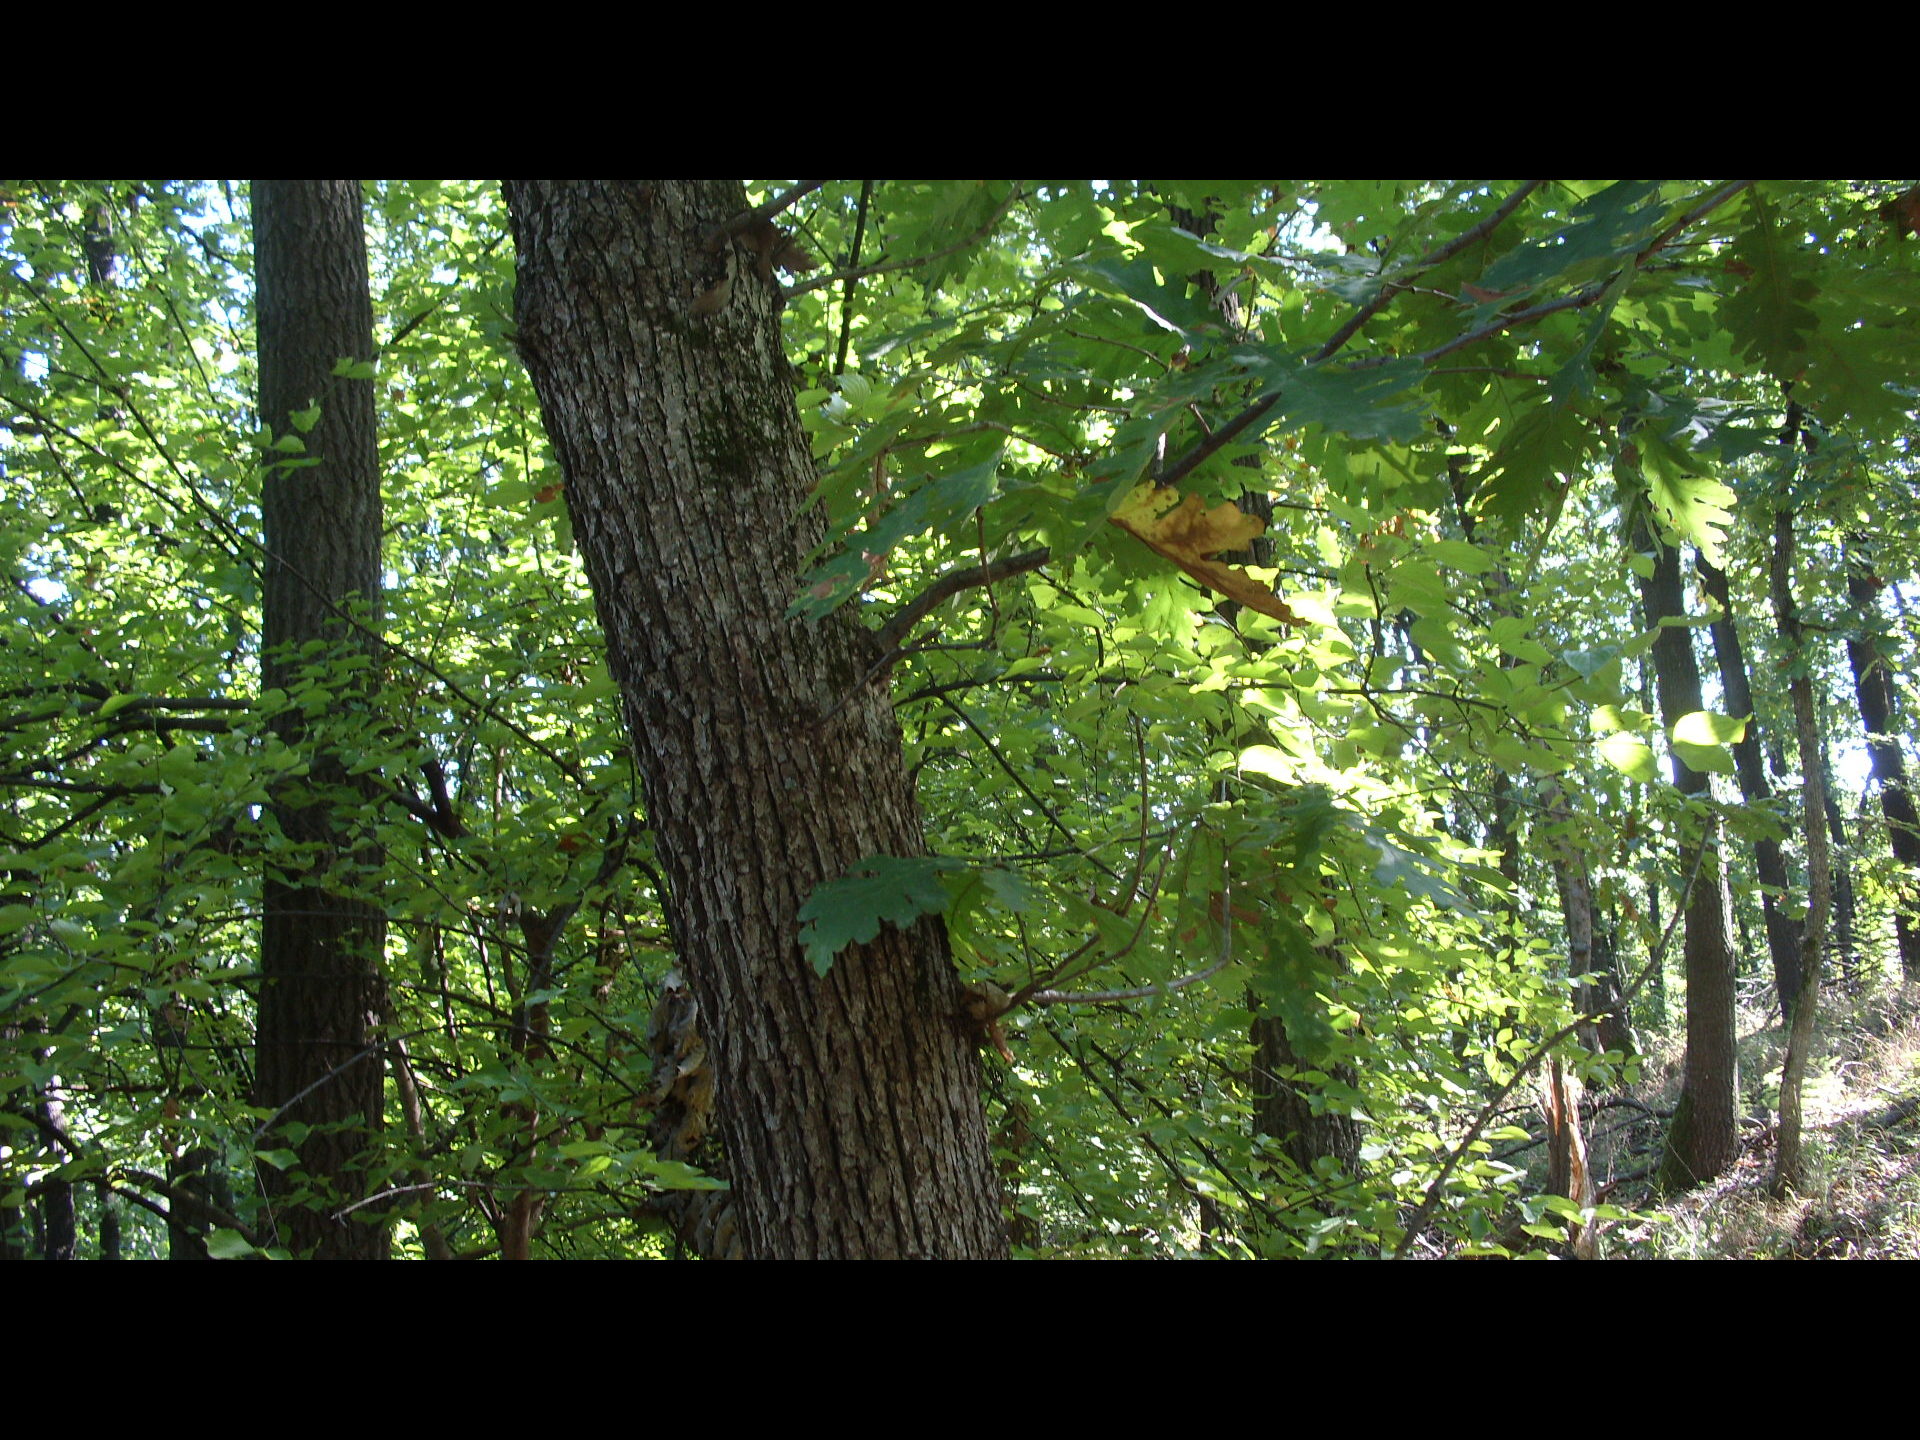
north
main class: Woodland
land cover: Broadleaved woodland
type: mesophytic deciduous forest
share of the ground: > 75 %
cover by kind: broadleaved forest trees 100 %
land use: Forestry
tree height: > 5 m
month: October
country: BG
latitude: 43.8746
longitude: 22.7175
